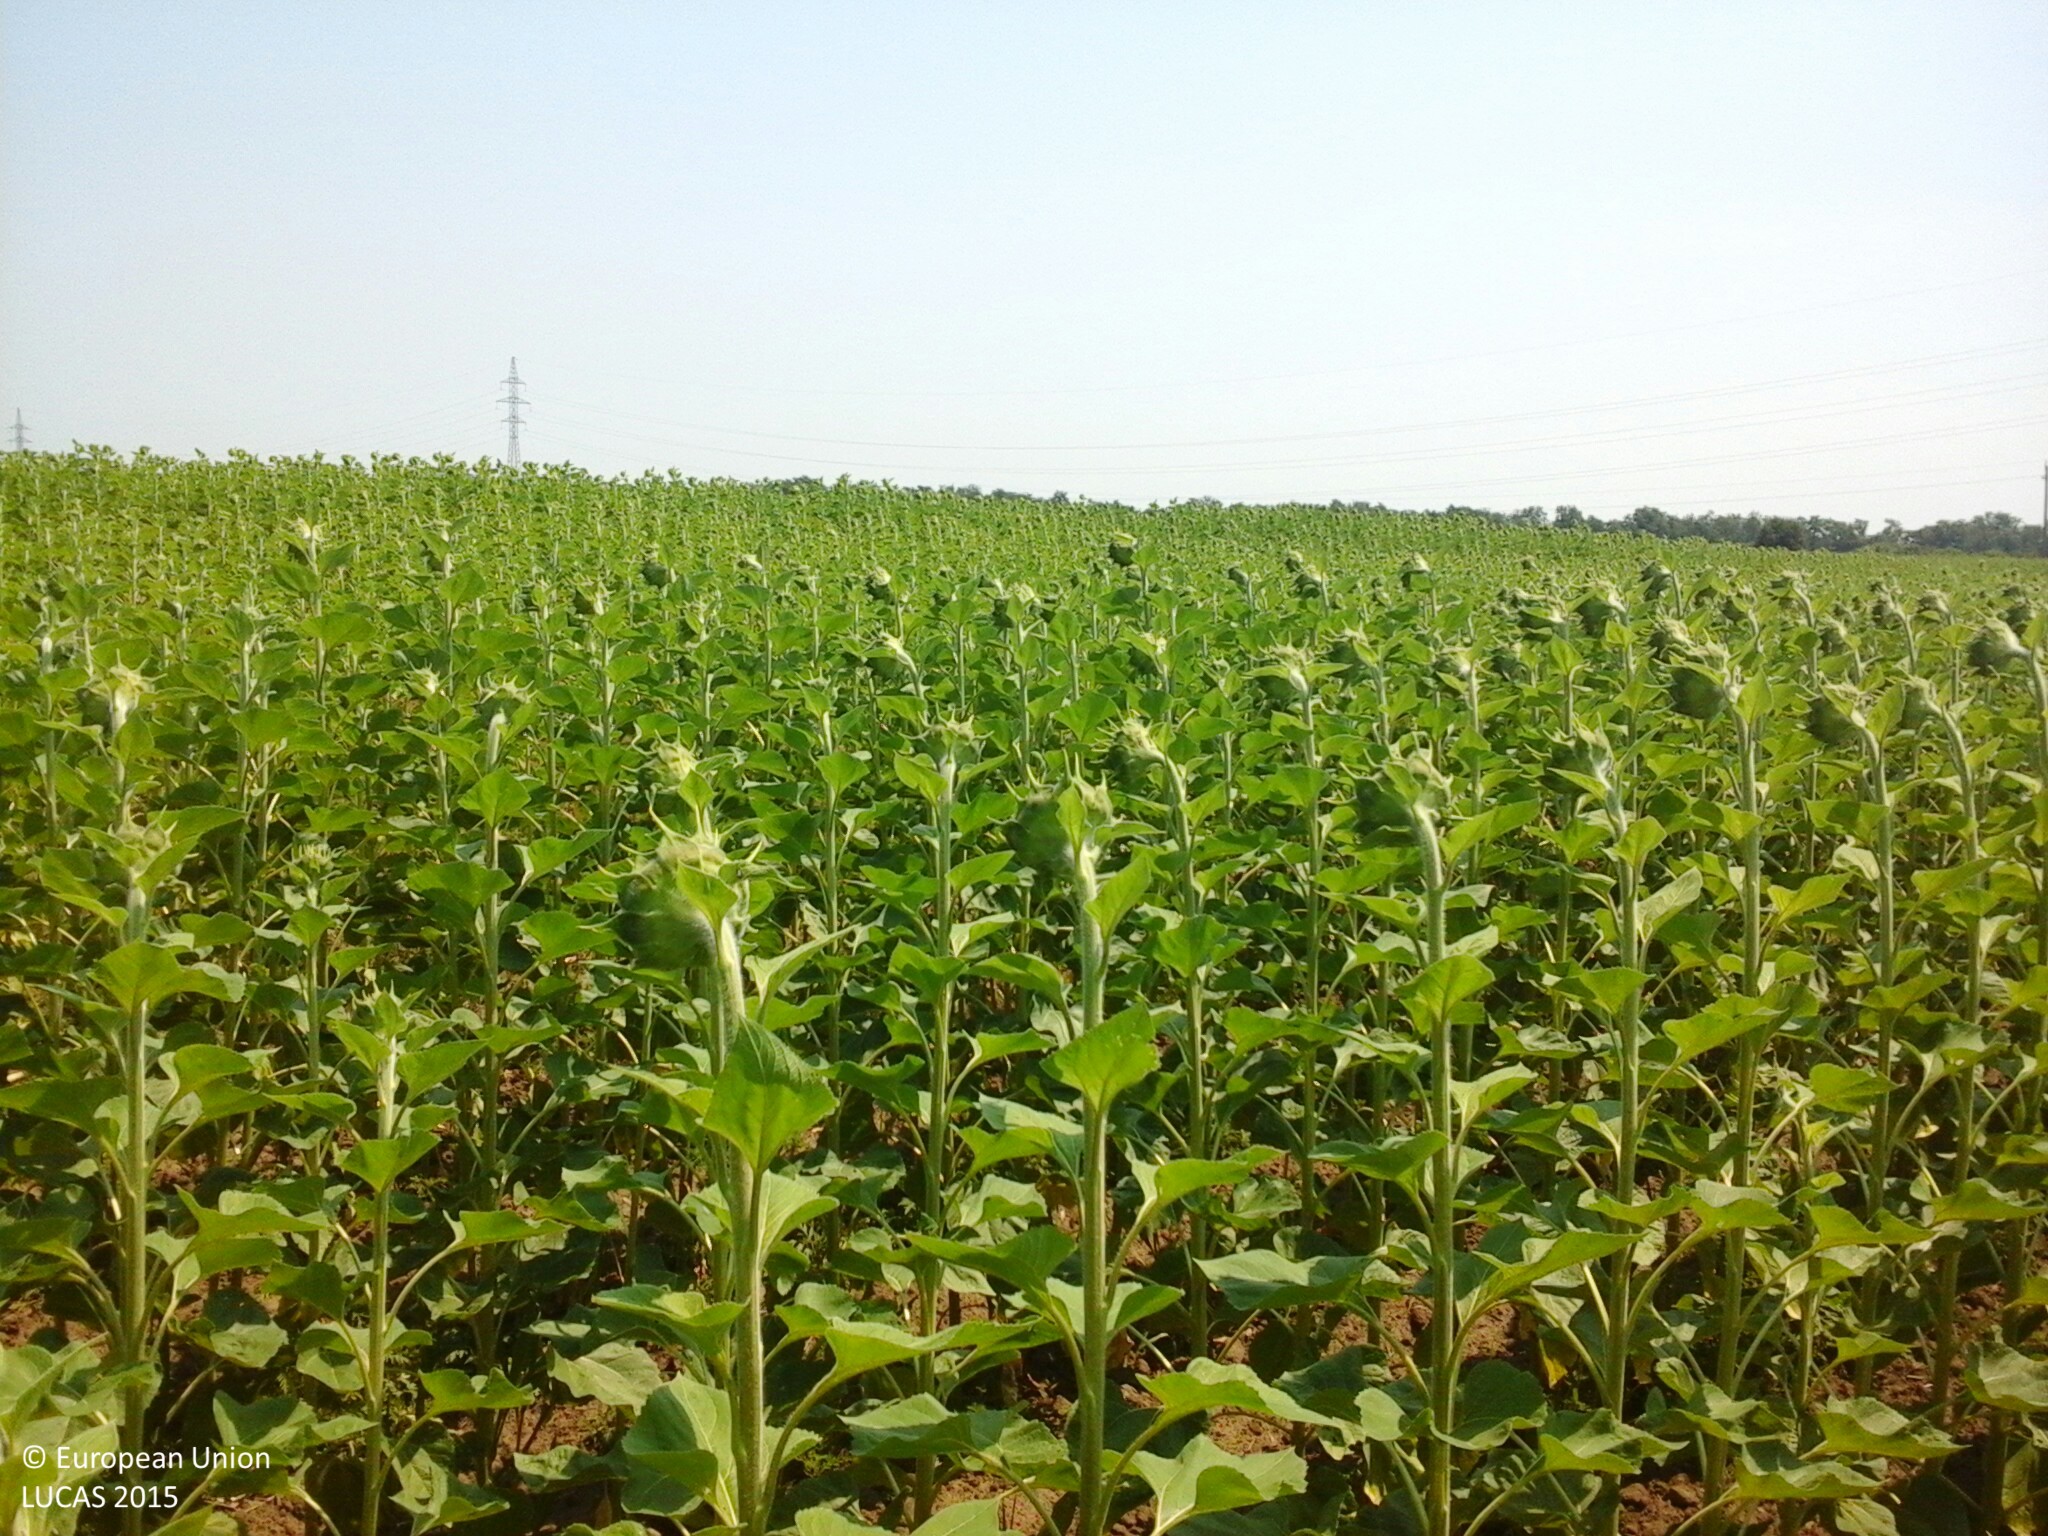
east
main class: Cropland
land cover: Sunflower
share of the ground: 50 - 75 %
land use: Agriculture (excluding fallow land and kitchen gardens)
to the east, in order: Sunflower; Fences; Potatoes; Other fruit trees and berries; Potatoes; Fences; Spontaneously vegetated surfaces
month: July
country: HU
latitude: 48.0410
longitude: 22.1395
